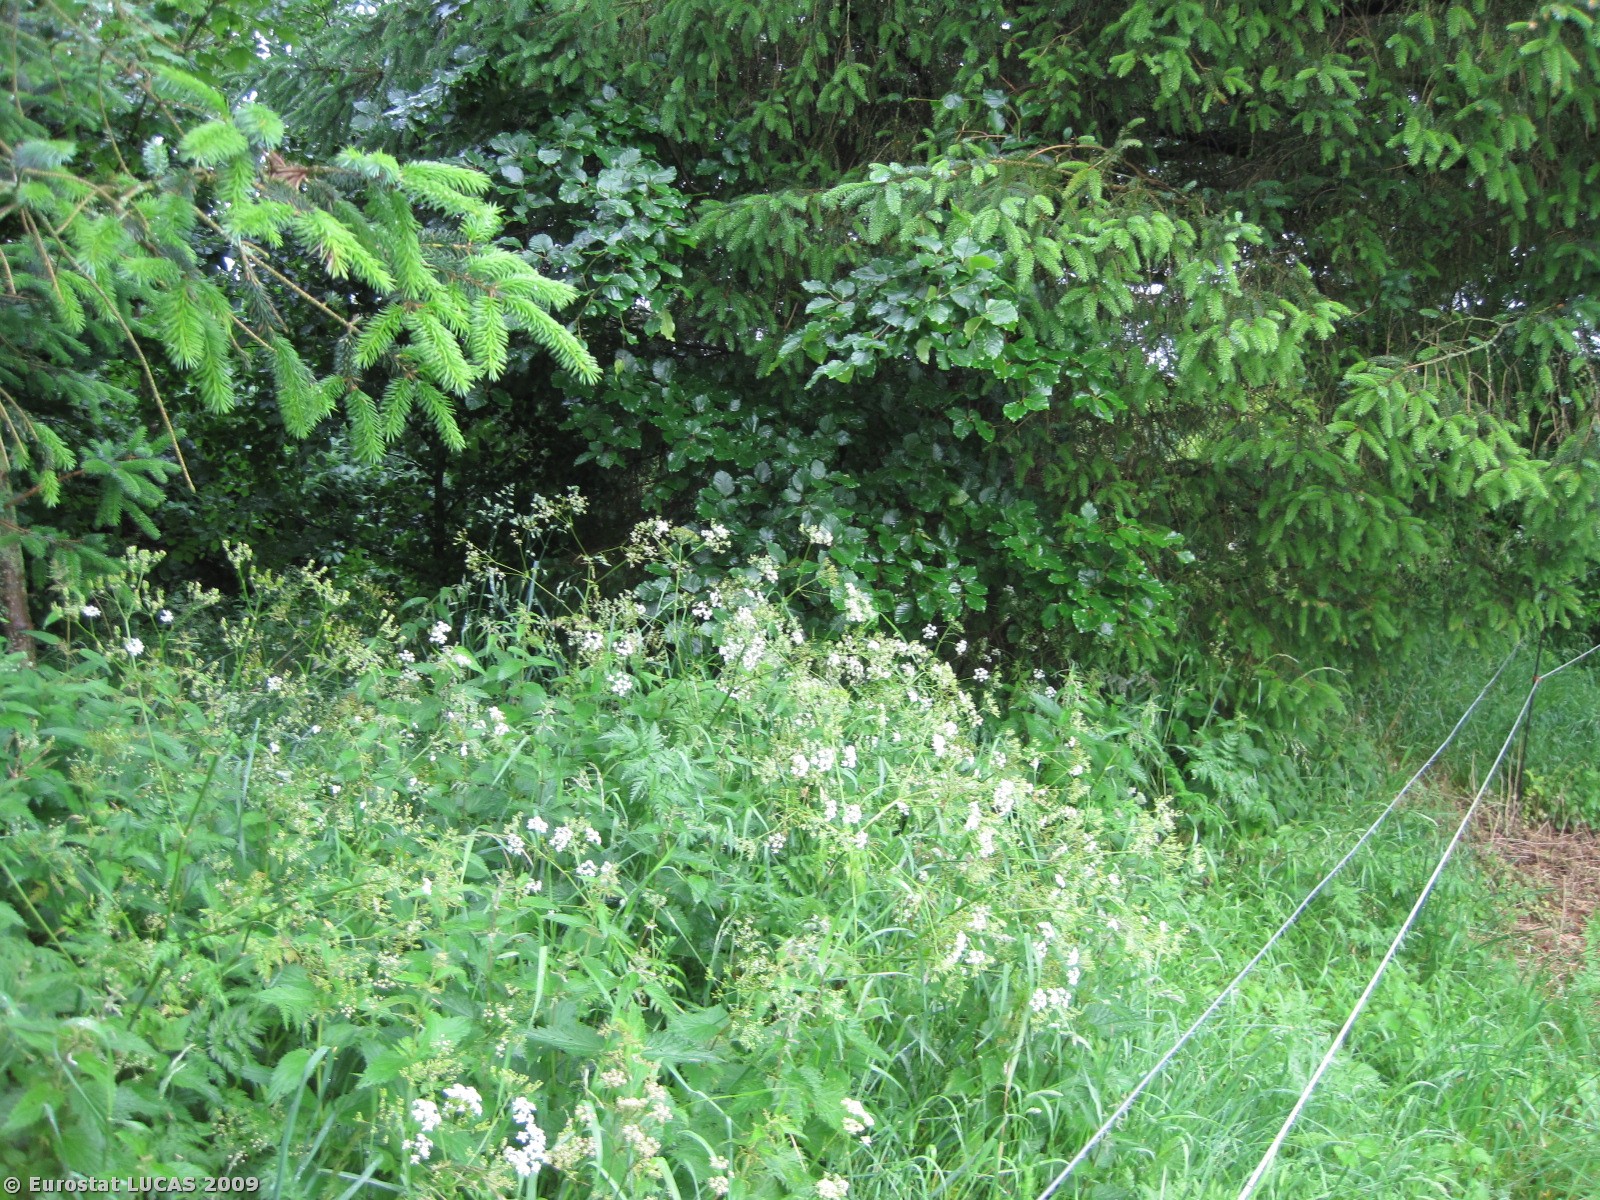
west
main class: Woodland
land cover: Mixed woodland
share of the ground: > 75 %
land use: Unused
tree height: > 5 m
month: June
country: DK
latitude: 57.5179
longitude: 10.2500
